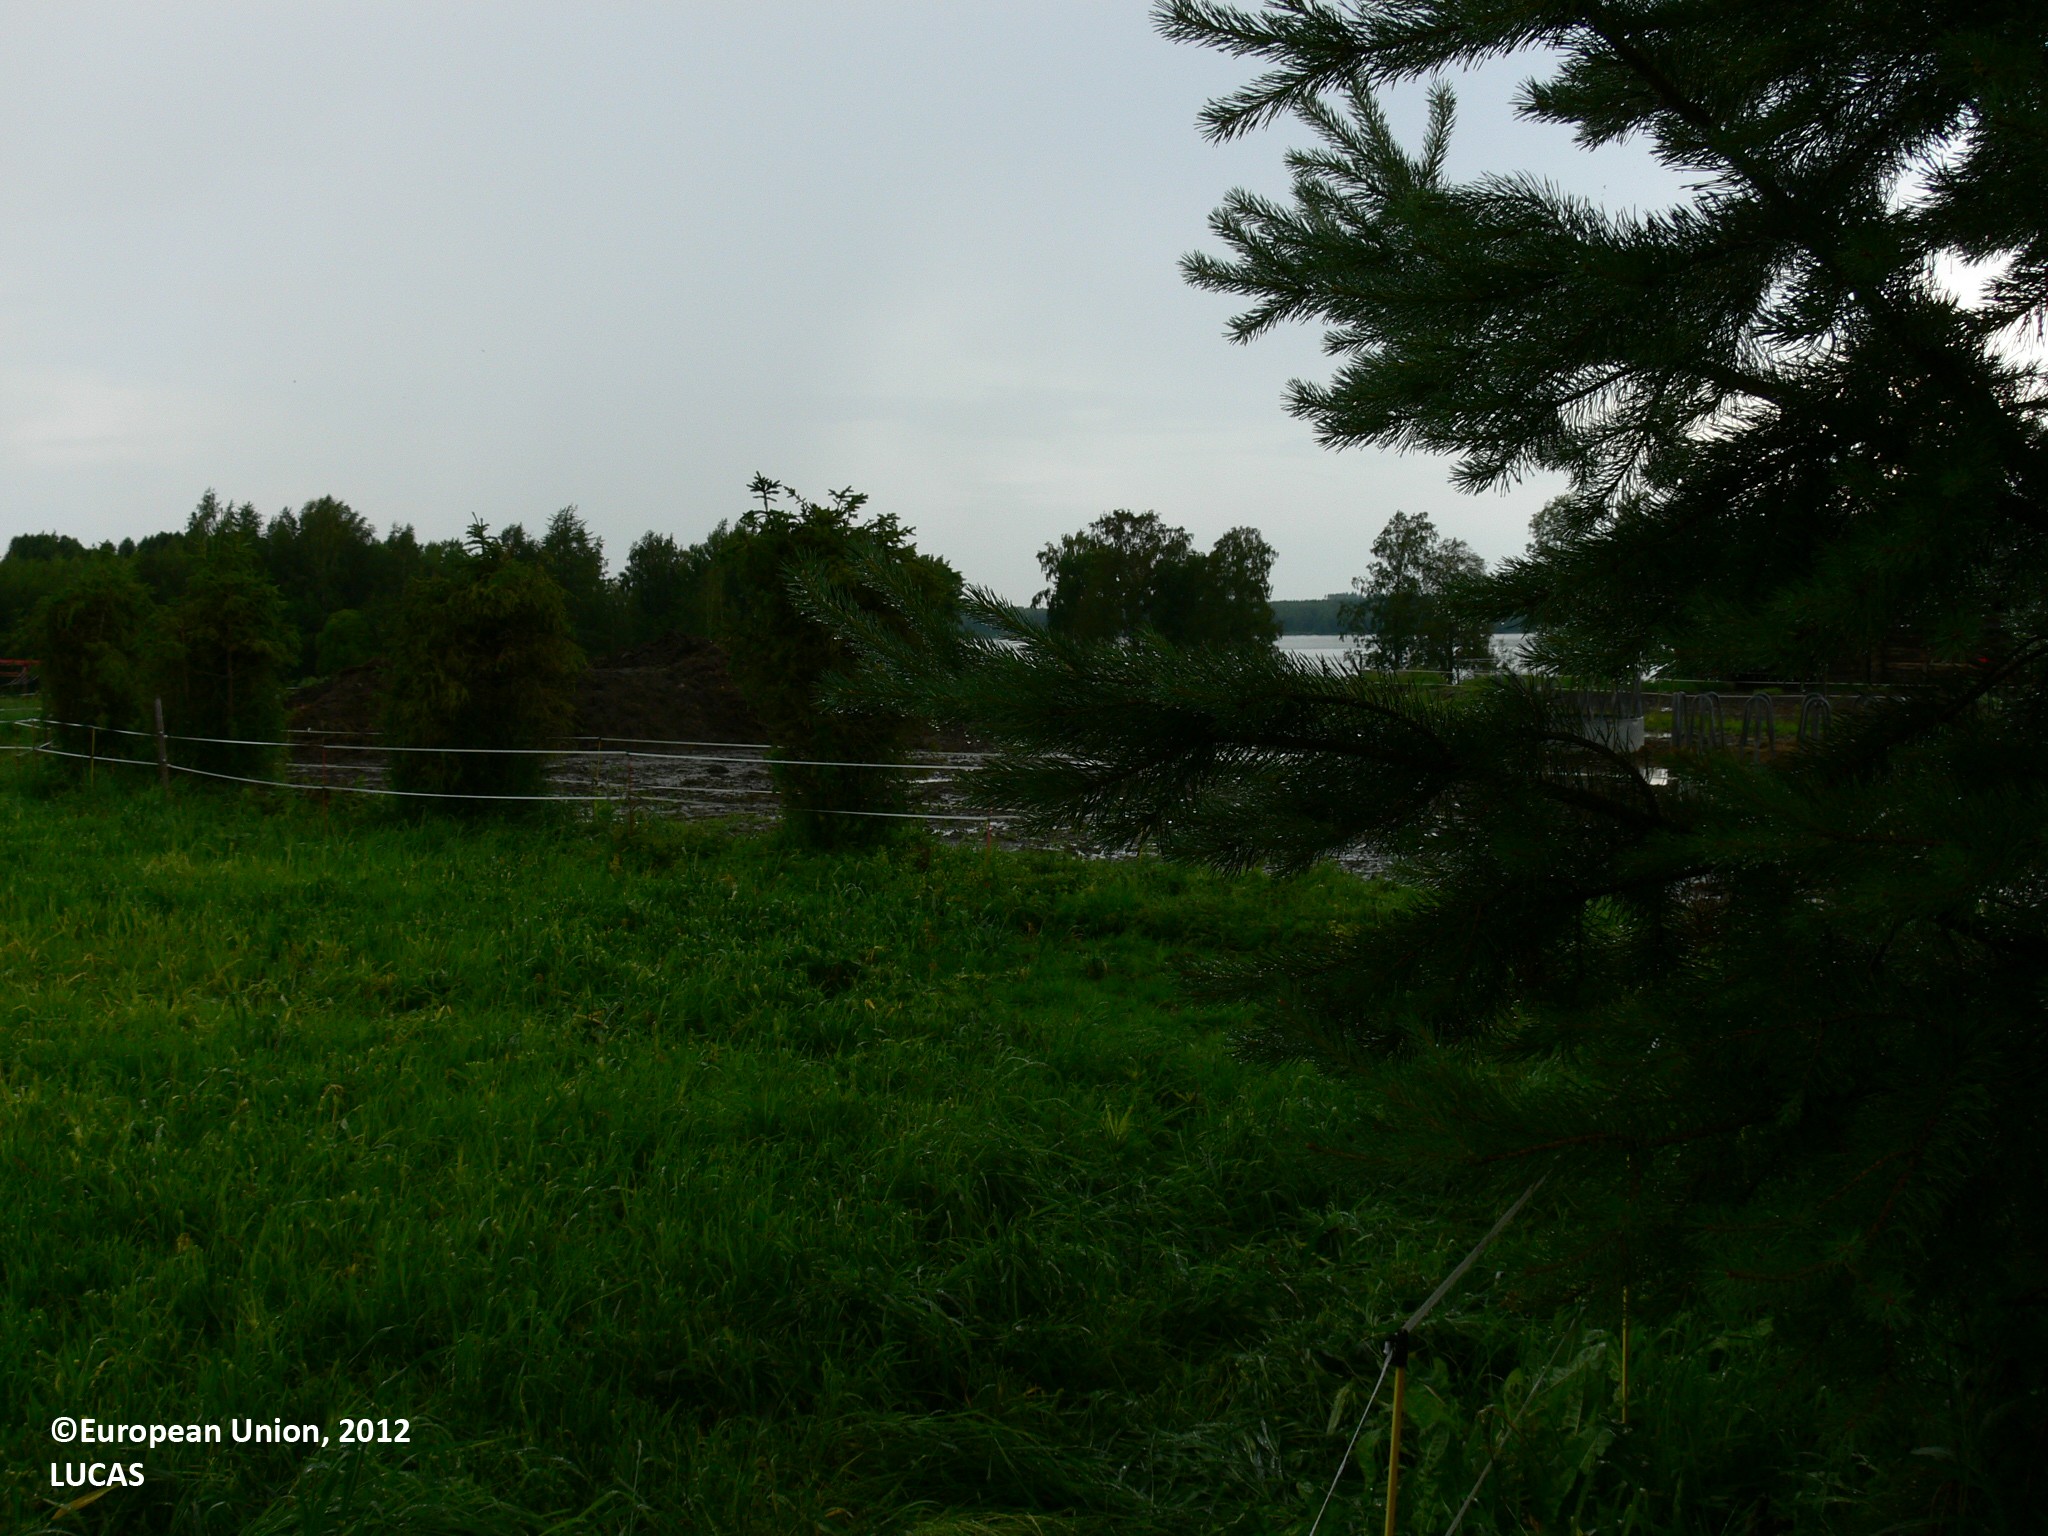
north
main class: Cropland
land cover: Temporary grasslands
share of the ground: > 75 %
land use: Agriculture (excluding fallow land and kitchen gardens)
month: July
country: FI
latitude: 63.2654
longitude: 30.0377
